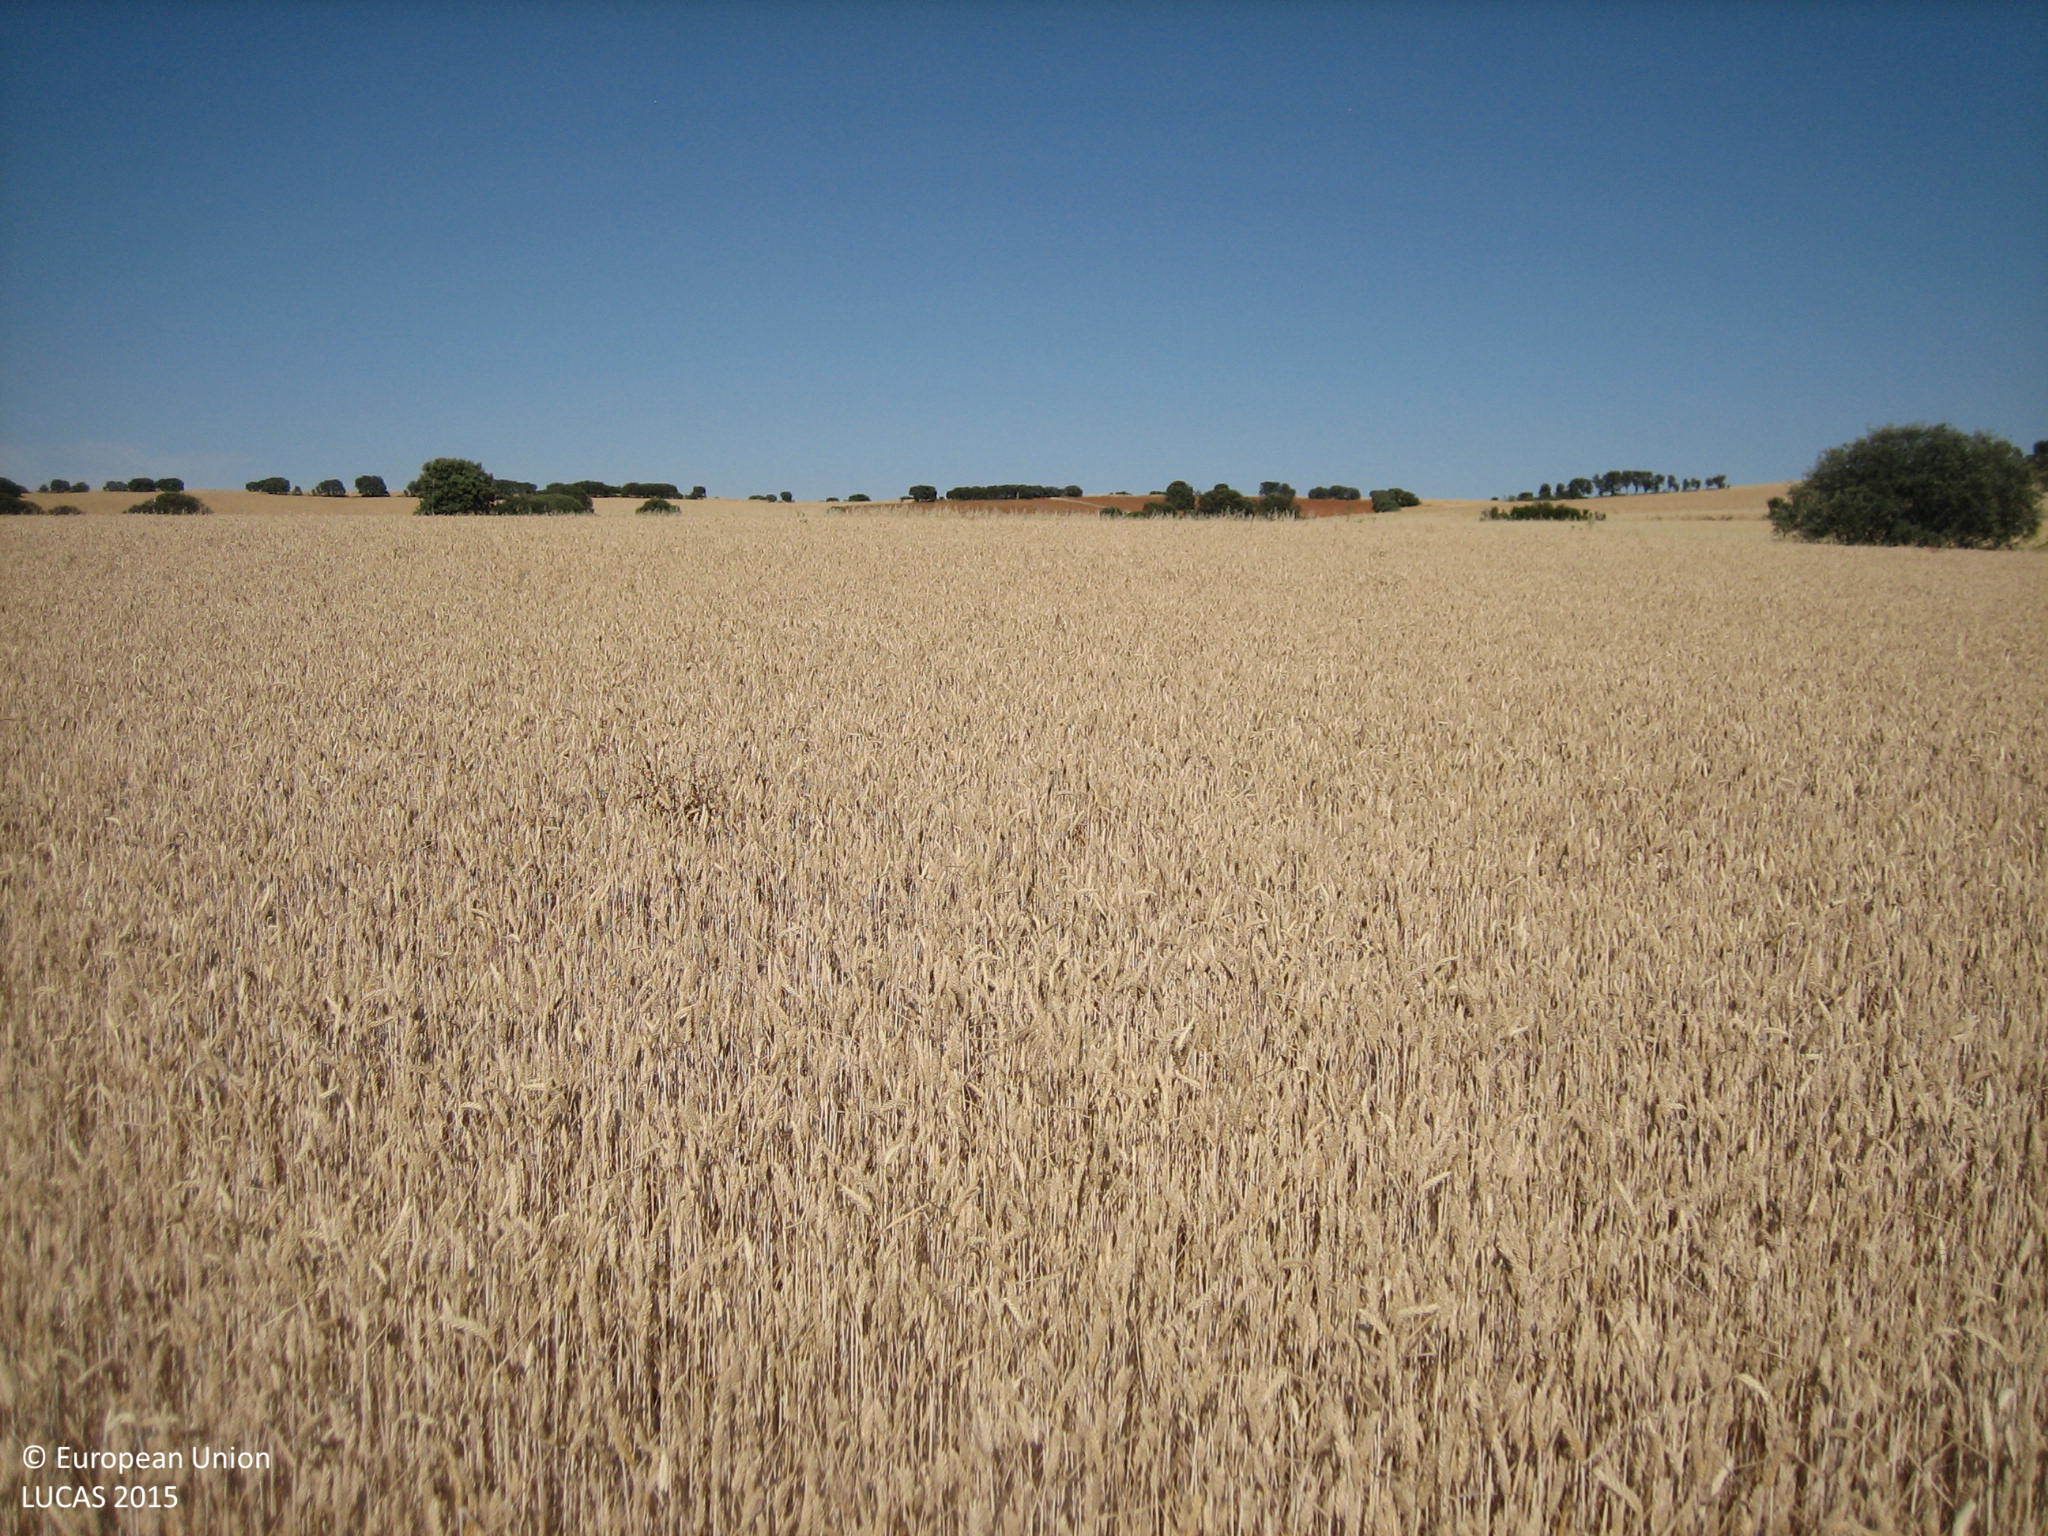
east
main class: Cropland
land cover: Common wheat
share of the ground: > 75 %
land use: Agriculture (excluding fallow land and kitchen gardens)
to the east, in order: Common wheat; Grass margins; Barley; Grass margins; Common wheat; Single bushes/trees; Barley
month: June
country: ES
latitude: 38.8806
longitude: -4.0726
